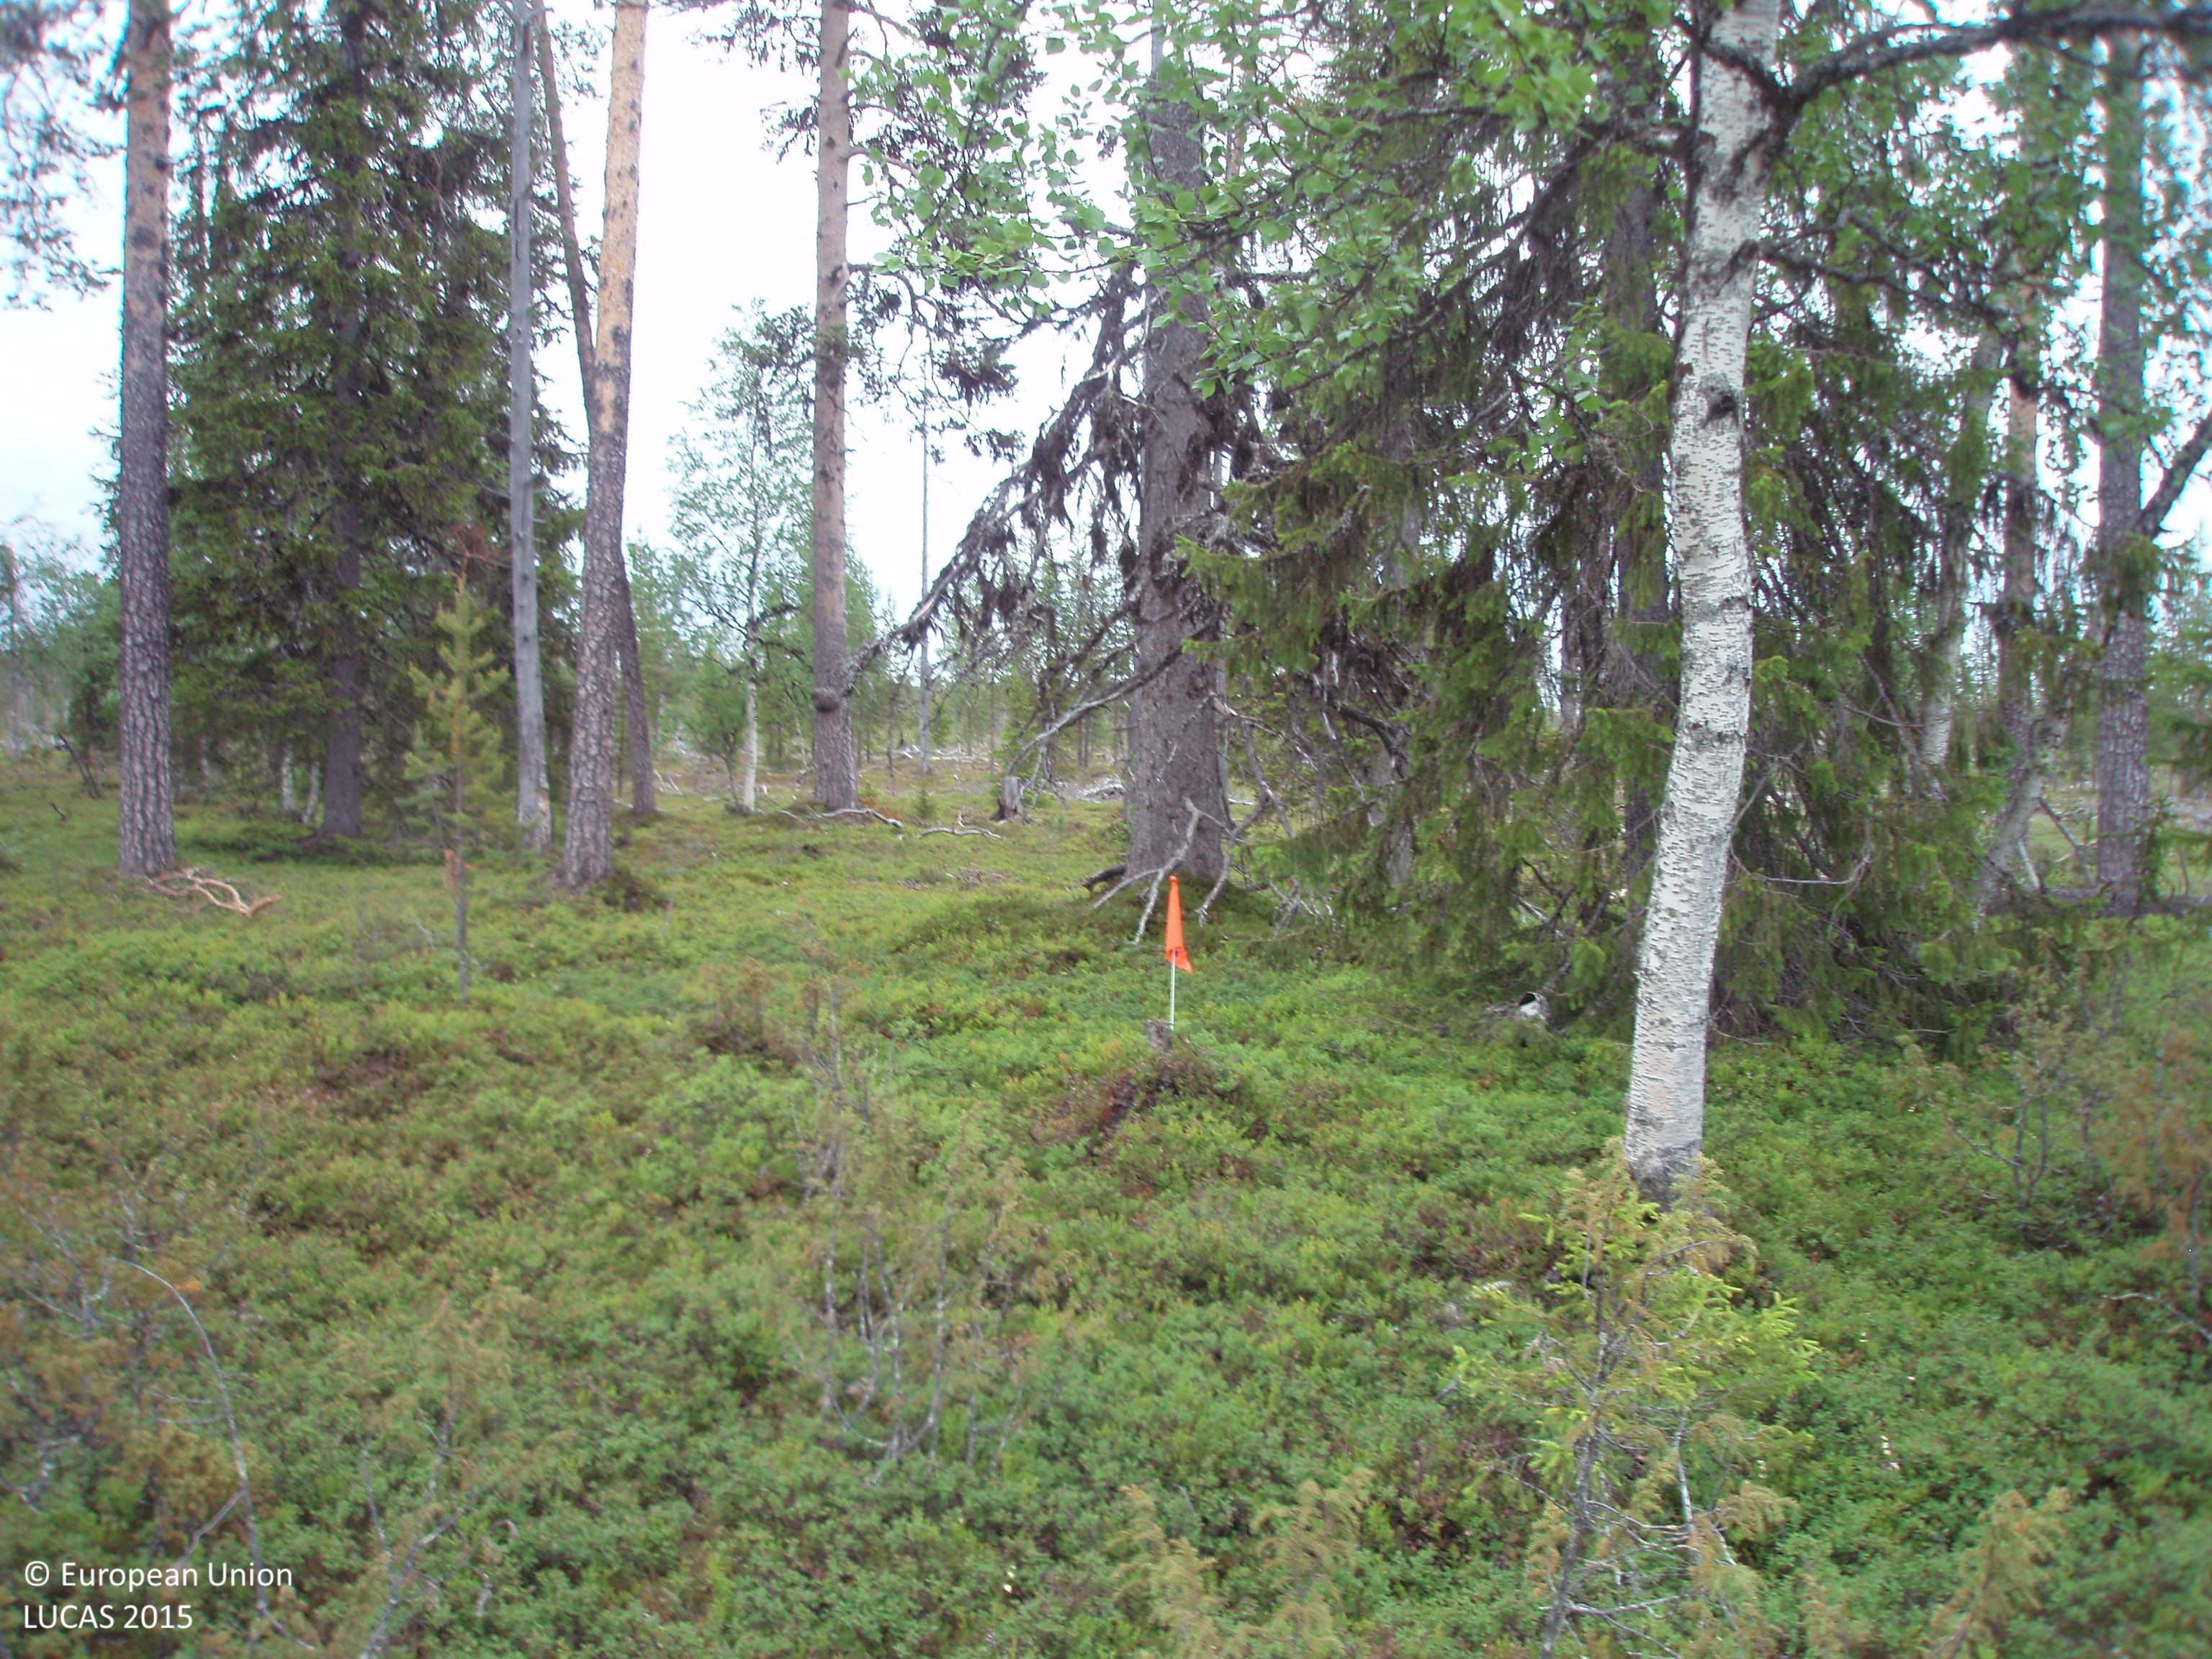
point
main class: Woodland
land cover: Other mixed woodland
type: boreal forest
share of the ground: 25 - 50 %
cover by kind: shrubs 55 %, coniferous forest trees 30 %, broadleaved forest trees 15 %
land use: Forestry
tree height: > 5 m
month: July
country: FI
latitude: 67.8660
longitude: 29.3443
